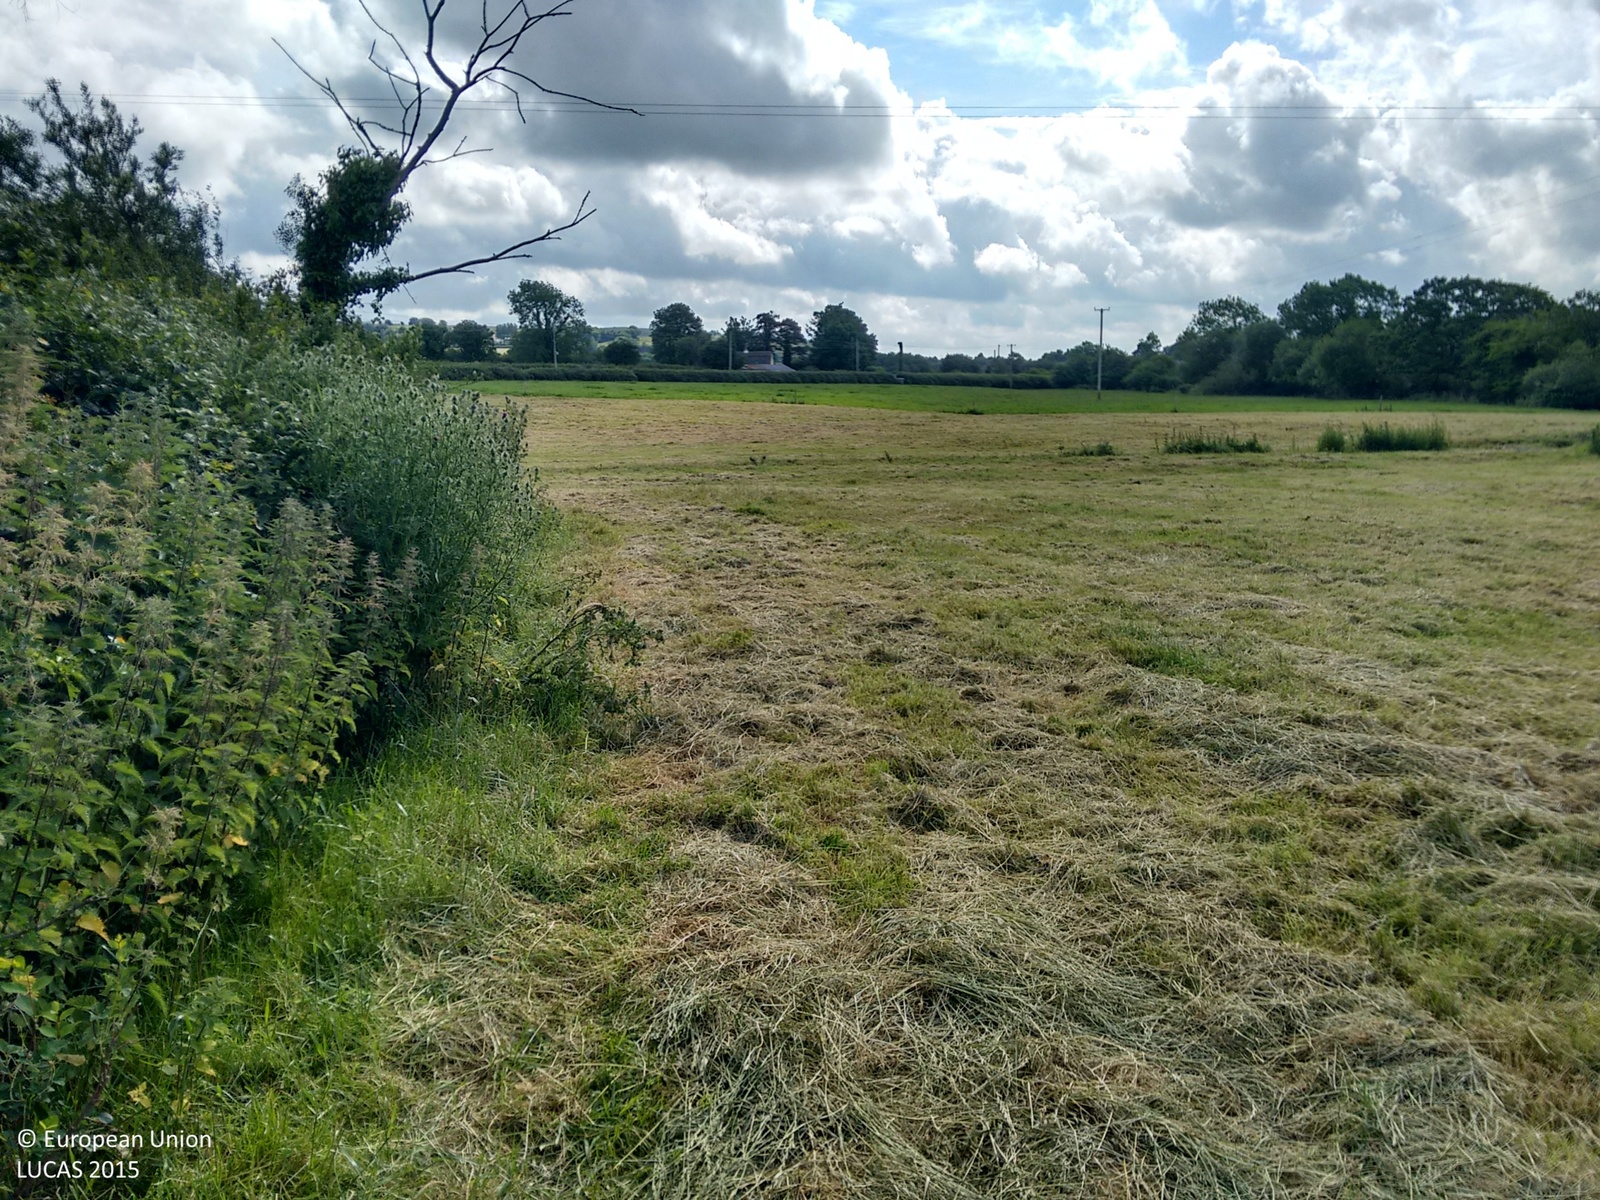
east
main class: Grassland
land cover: Grassland with sparse tree/shrub cover
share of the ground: > 75 %
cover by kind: herbaceous plants 95 %, broadleaved forest trees 5 %
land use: Residential
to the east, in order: Grassland with sparse tree/shrub cover; Artificial constructions in urban areas; Fences; Grassland without tree/shrub cover; Rivers and streams; Grassland without tree/shrub cover; Fences; Grassland without tree/shrub cover; Abandoned hedges; Electric lines; Grass margins; Paved roads, cycling and walking lanes; Abandoned hedges; Electric lines; Grass margins; Fences; Grassland without tree/shrub cover; Fences; Abandoned hedges; Grassland without tree/shrub cover
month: July
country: IE
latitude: 52.5218
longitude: -7.5974
